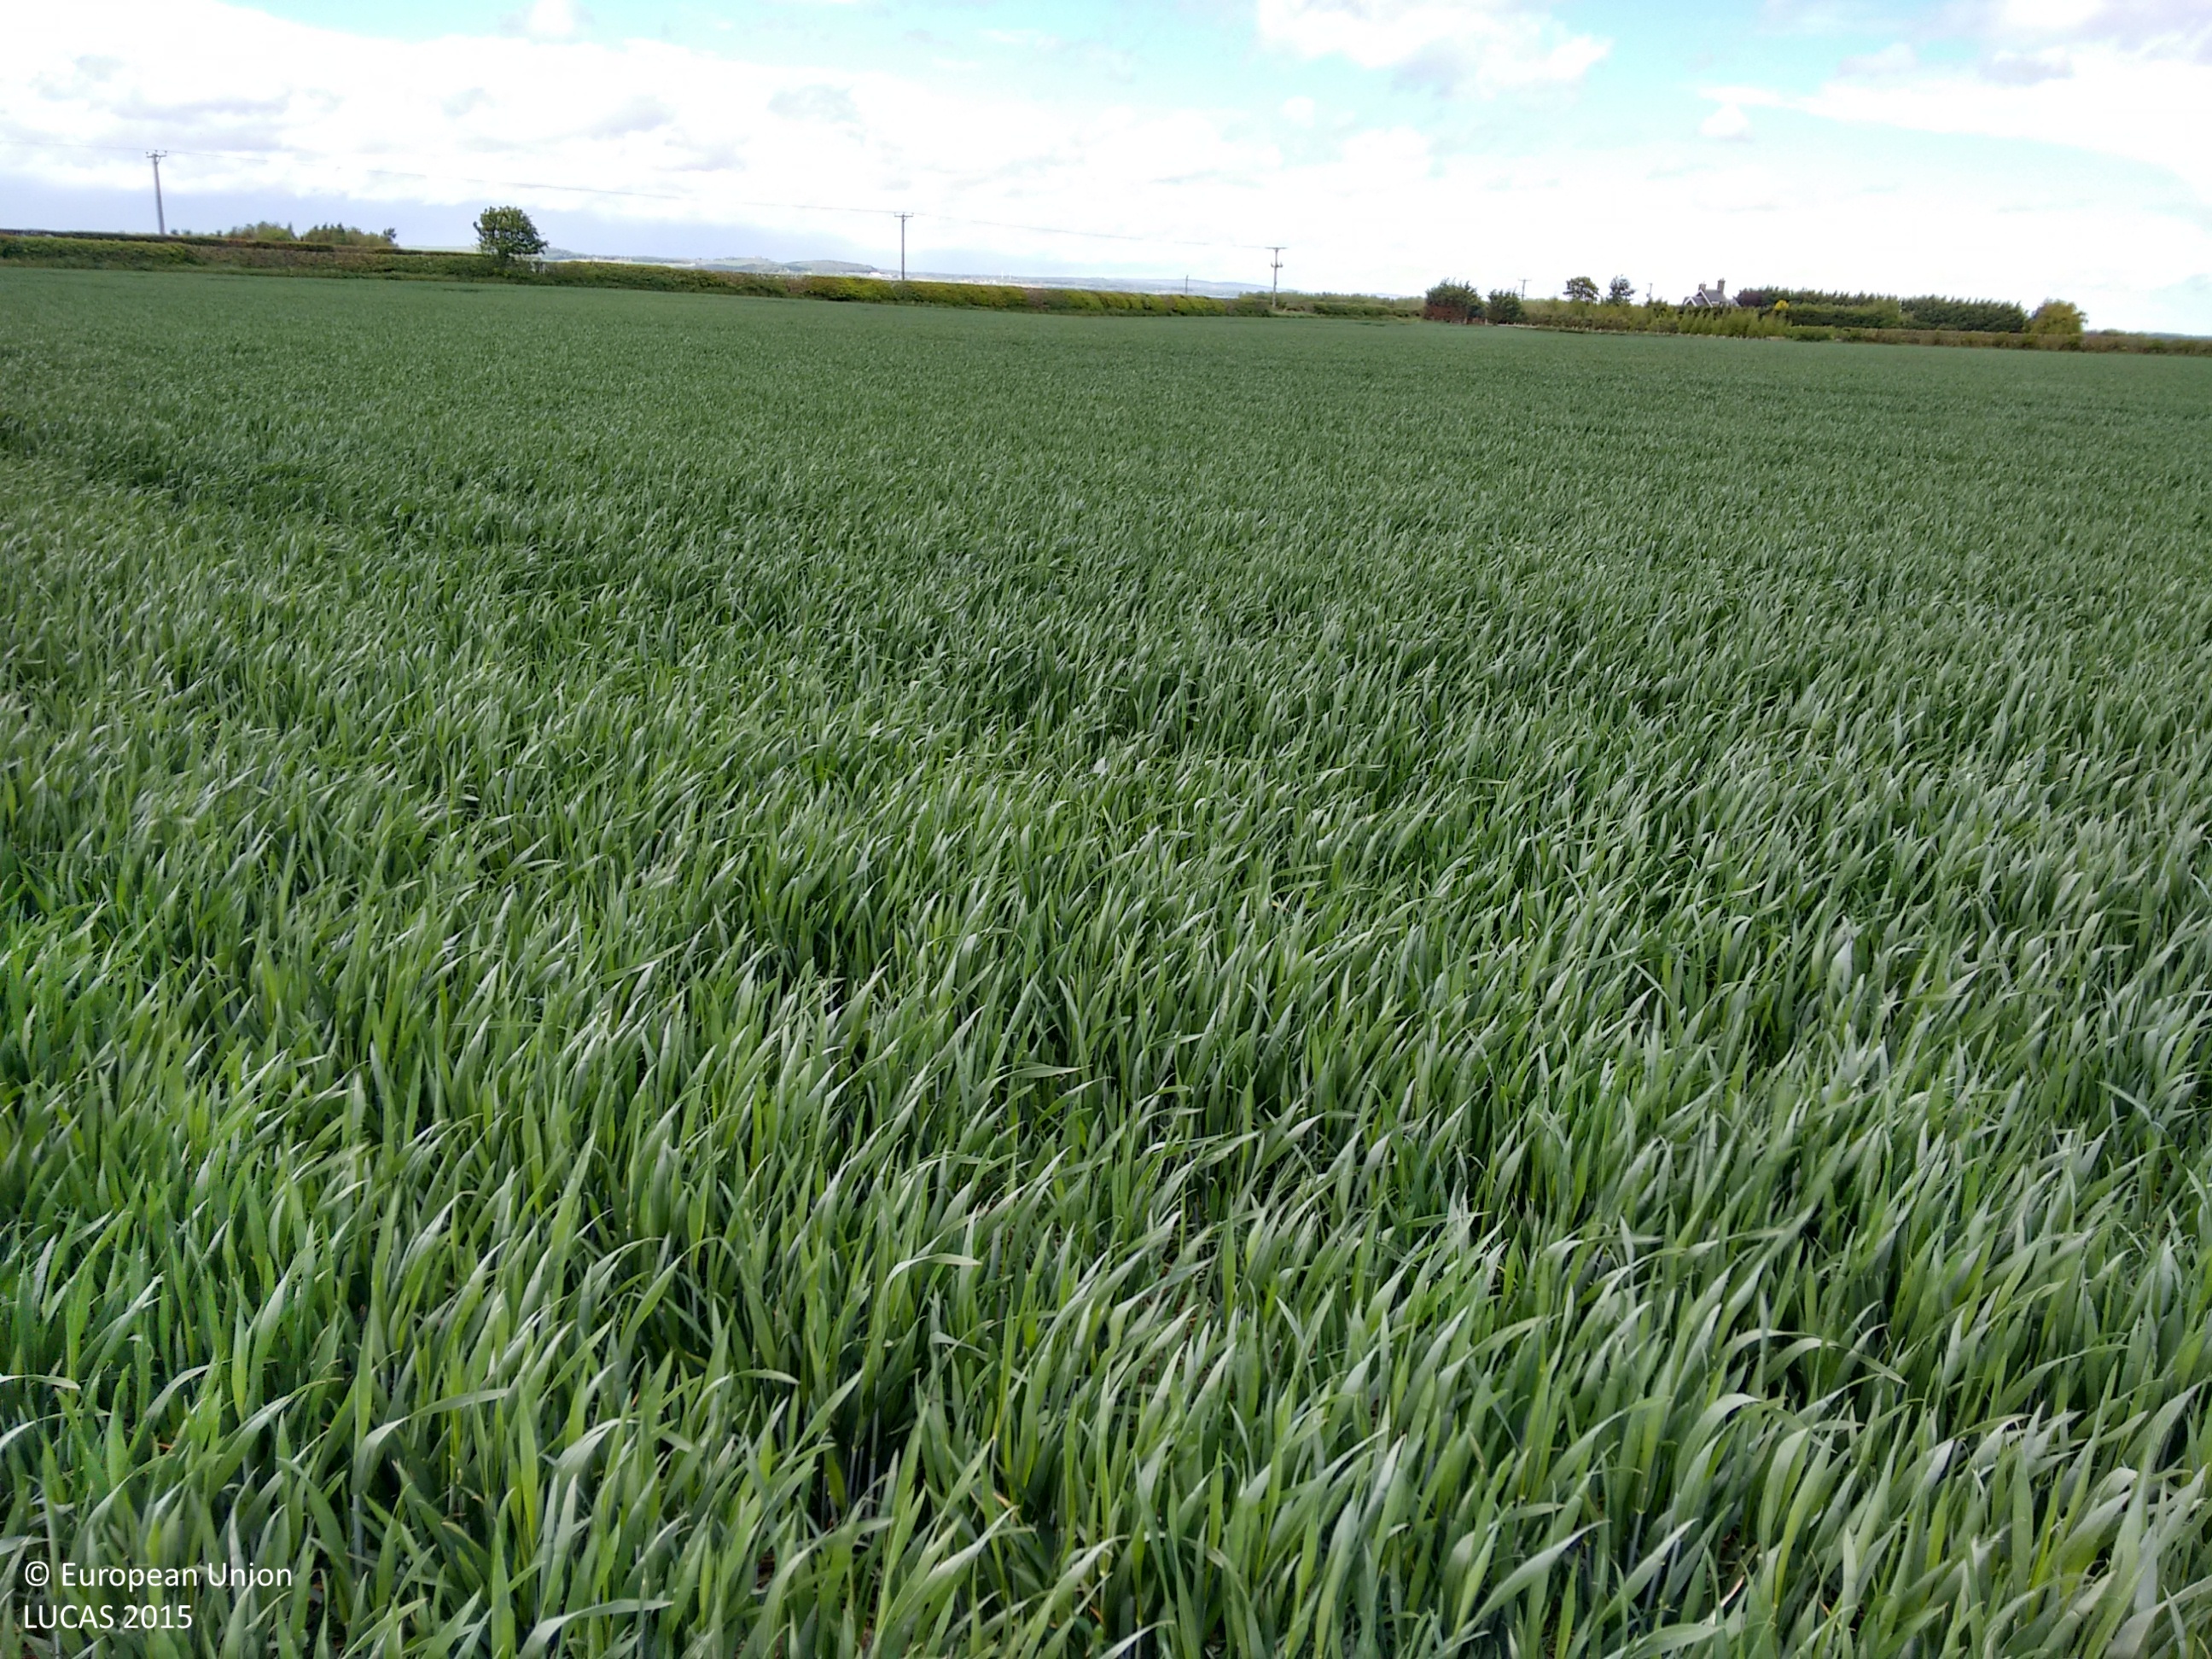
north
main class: Cropland
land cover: Barley
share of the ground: > 75 %
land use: Agriculture (excluding fallow land and kitchen gardens)
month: May
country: GB
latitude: 55.5786
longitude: -2.4484
